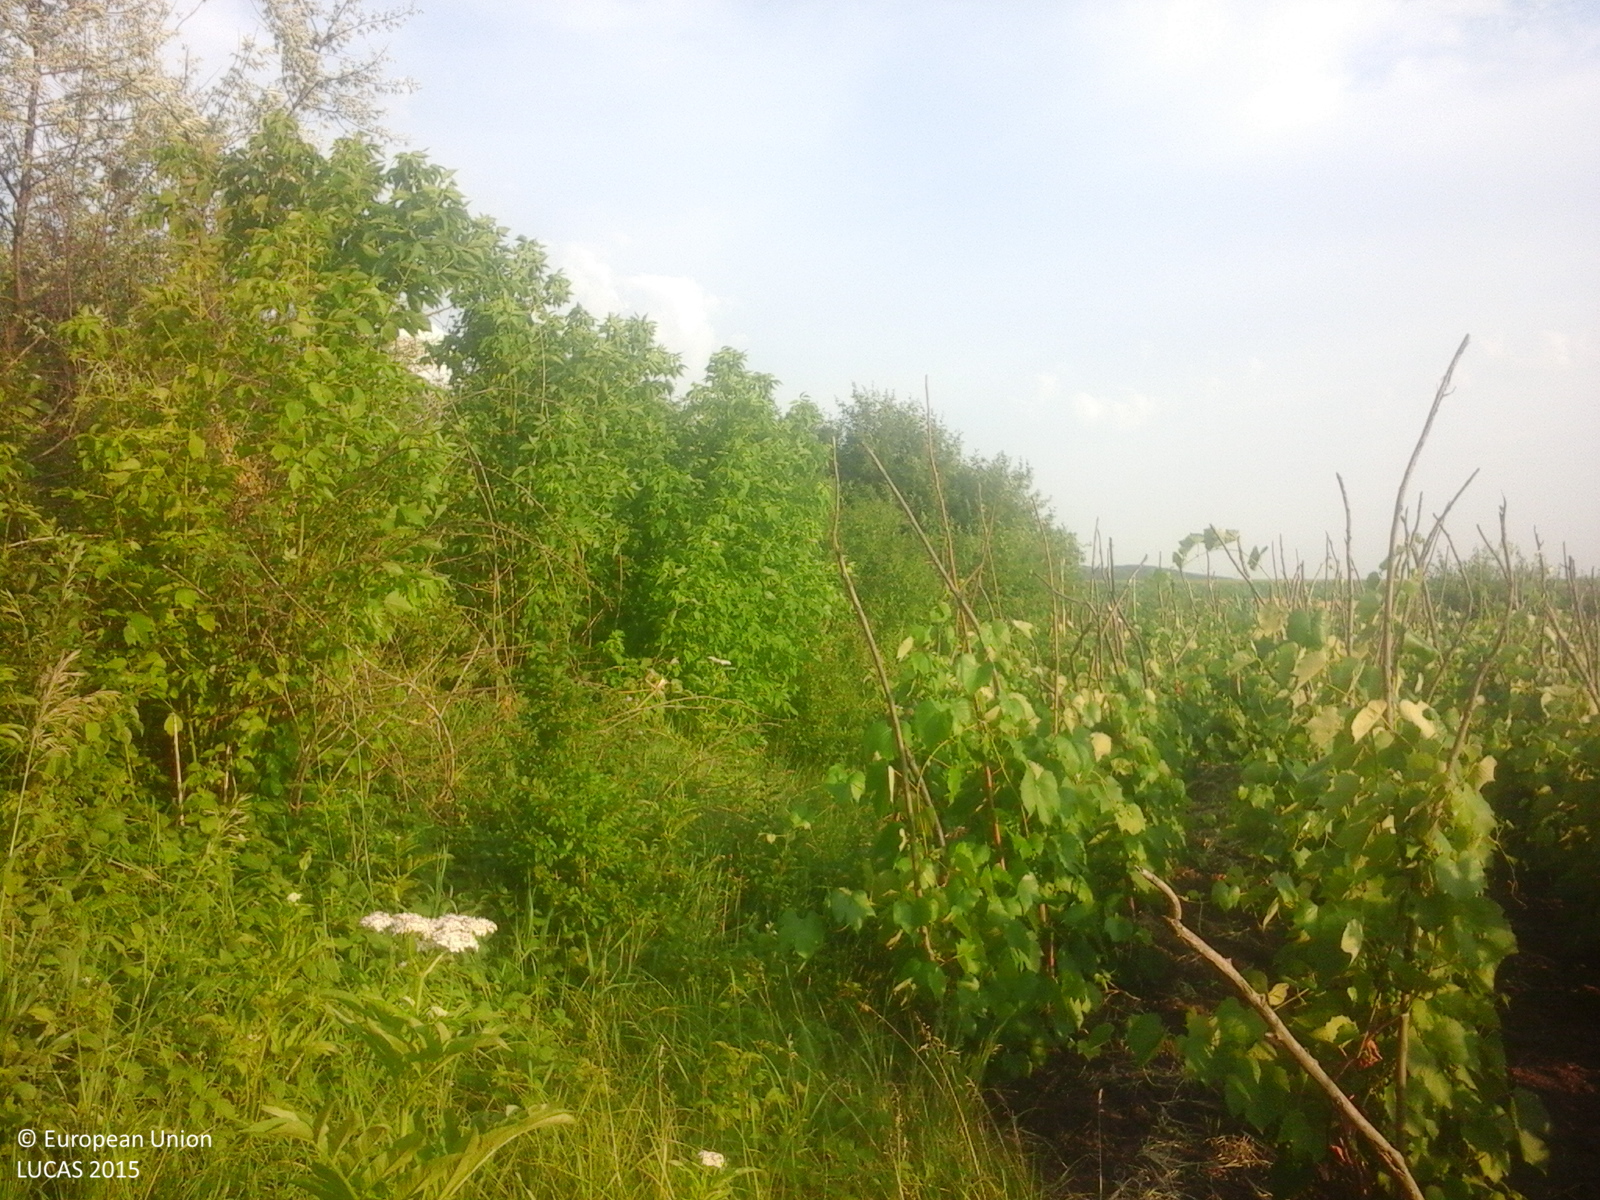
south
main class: Shrubland
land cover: Shrubland with sparse tree cover
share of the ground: > 75 %
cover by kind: shrubs 95 %, broadleaved forest trees 5 %
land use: Semi-natural and natural areas not in use
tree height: < 5 m
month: June
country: RO
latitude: 46.7442
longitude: 27.7782
